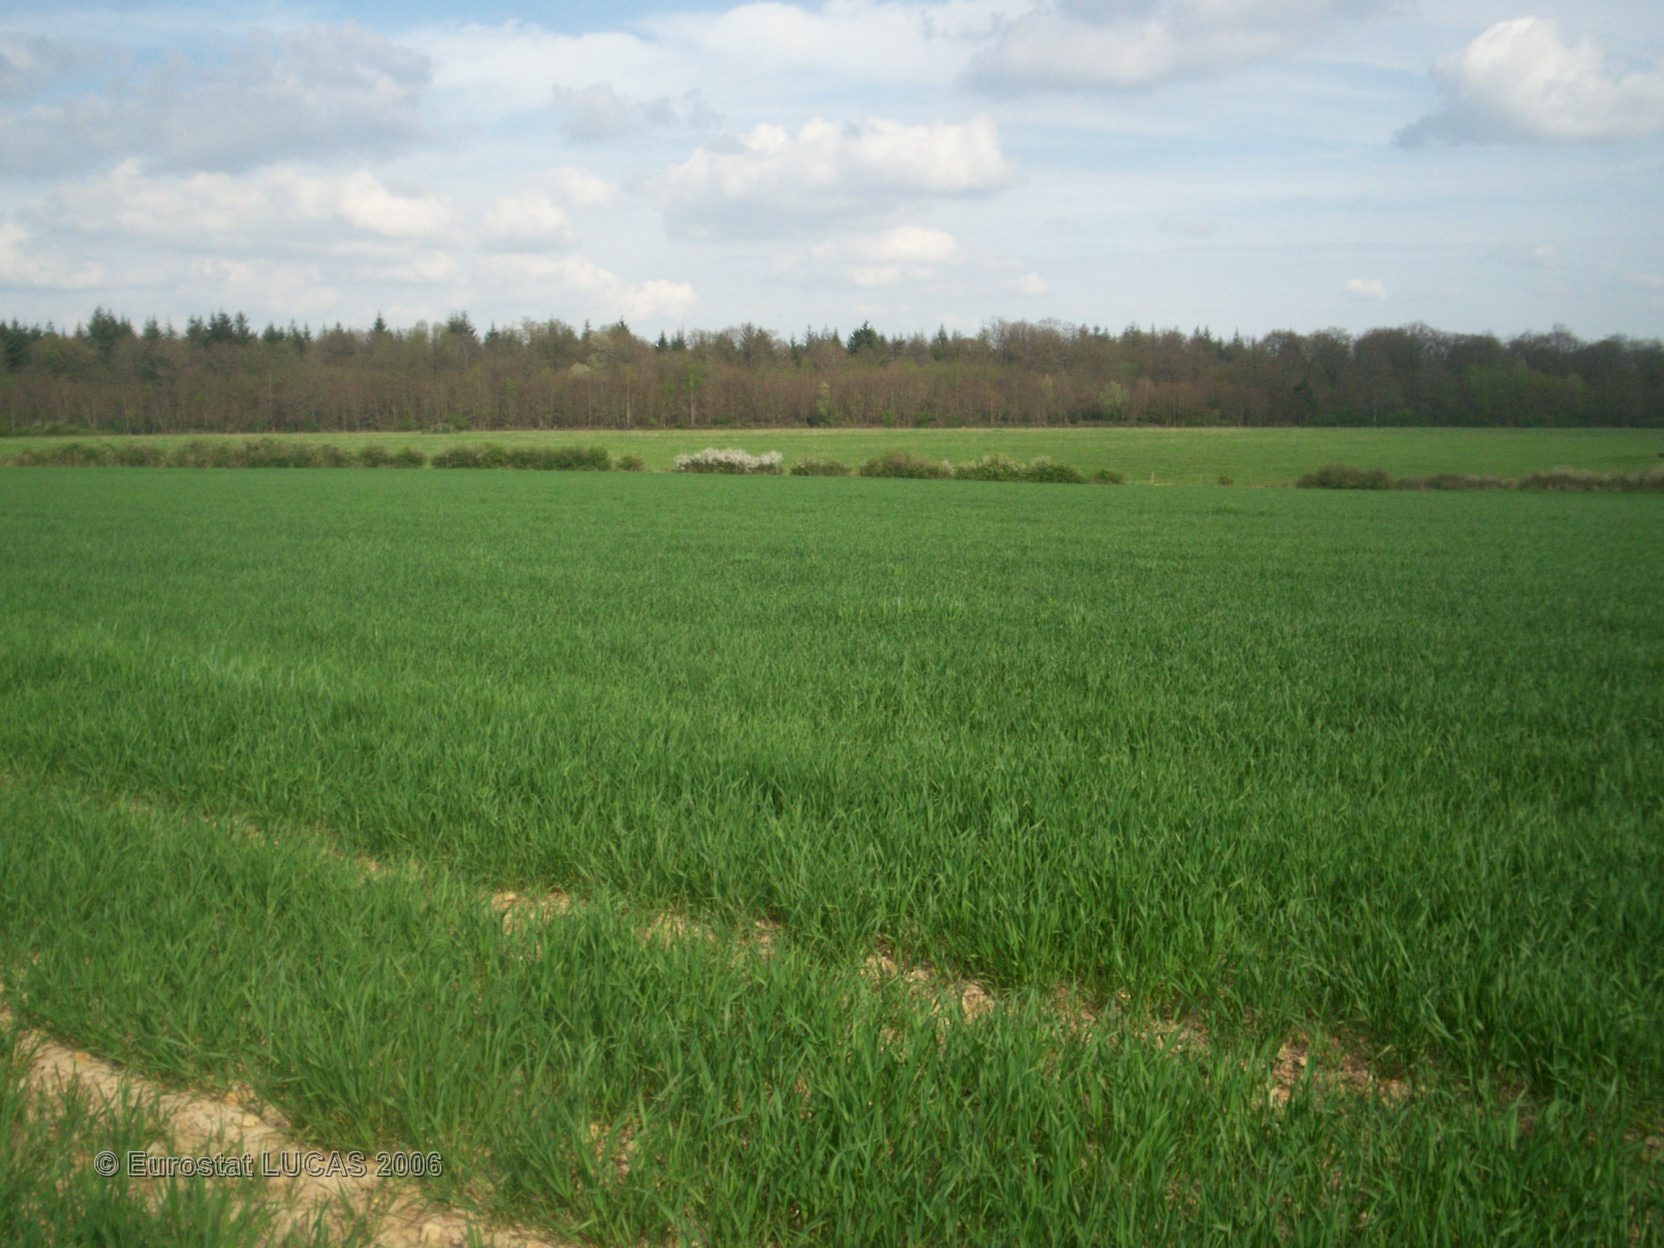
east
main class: Cropland
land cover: Common wheat
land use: Agriculture (excluding fallow land and kitchen gardens)
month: April
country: FR
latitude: 47.7891
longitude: 0.8635
